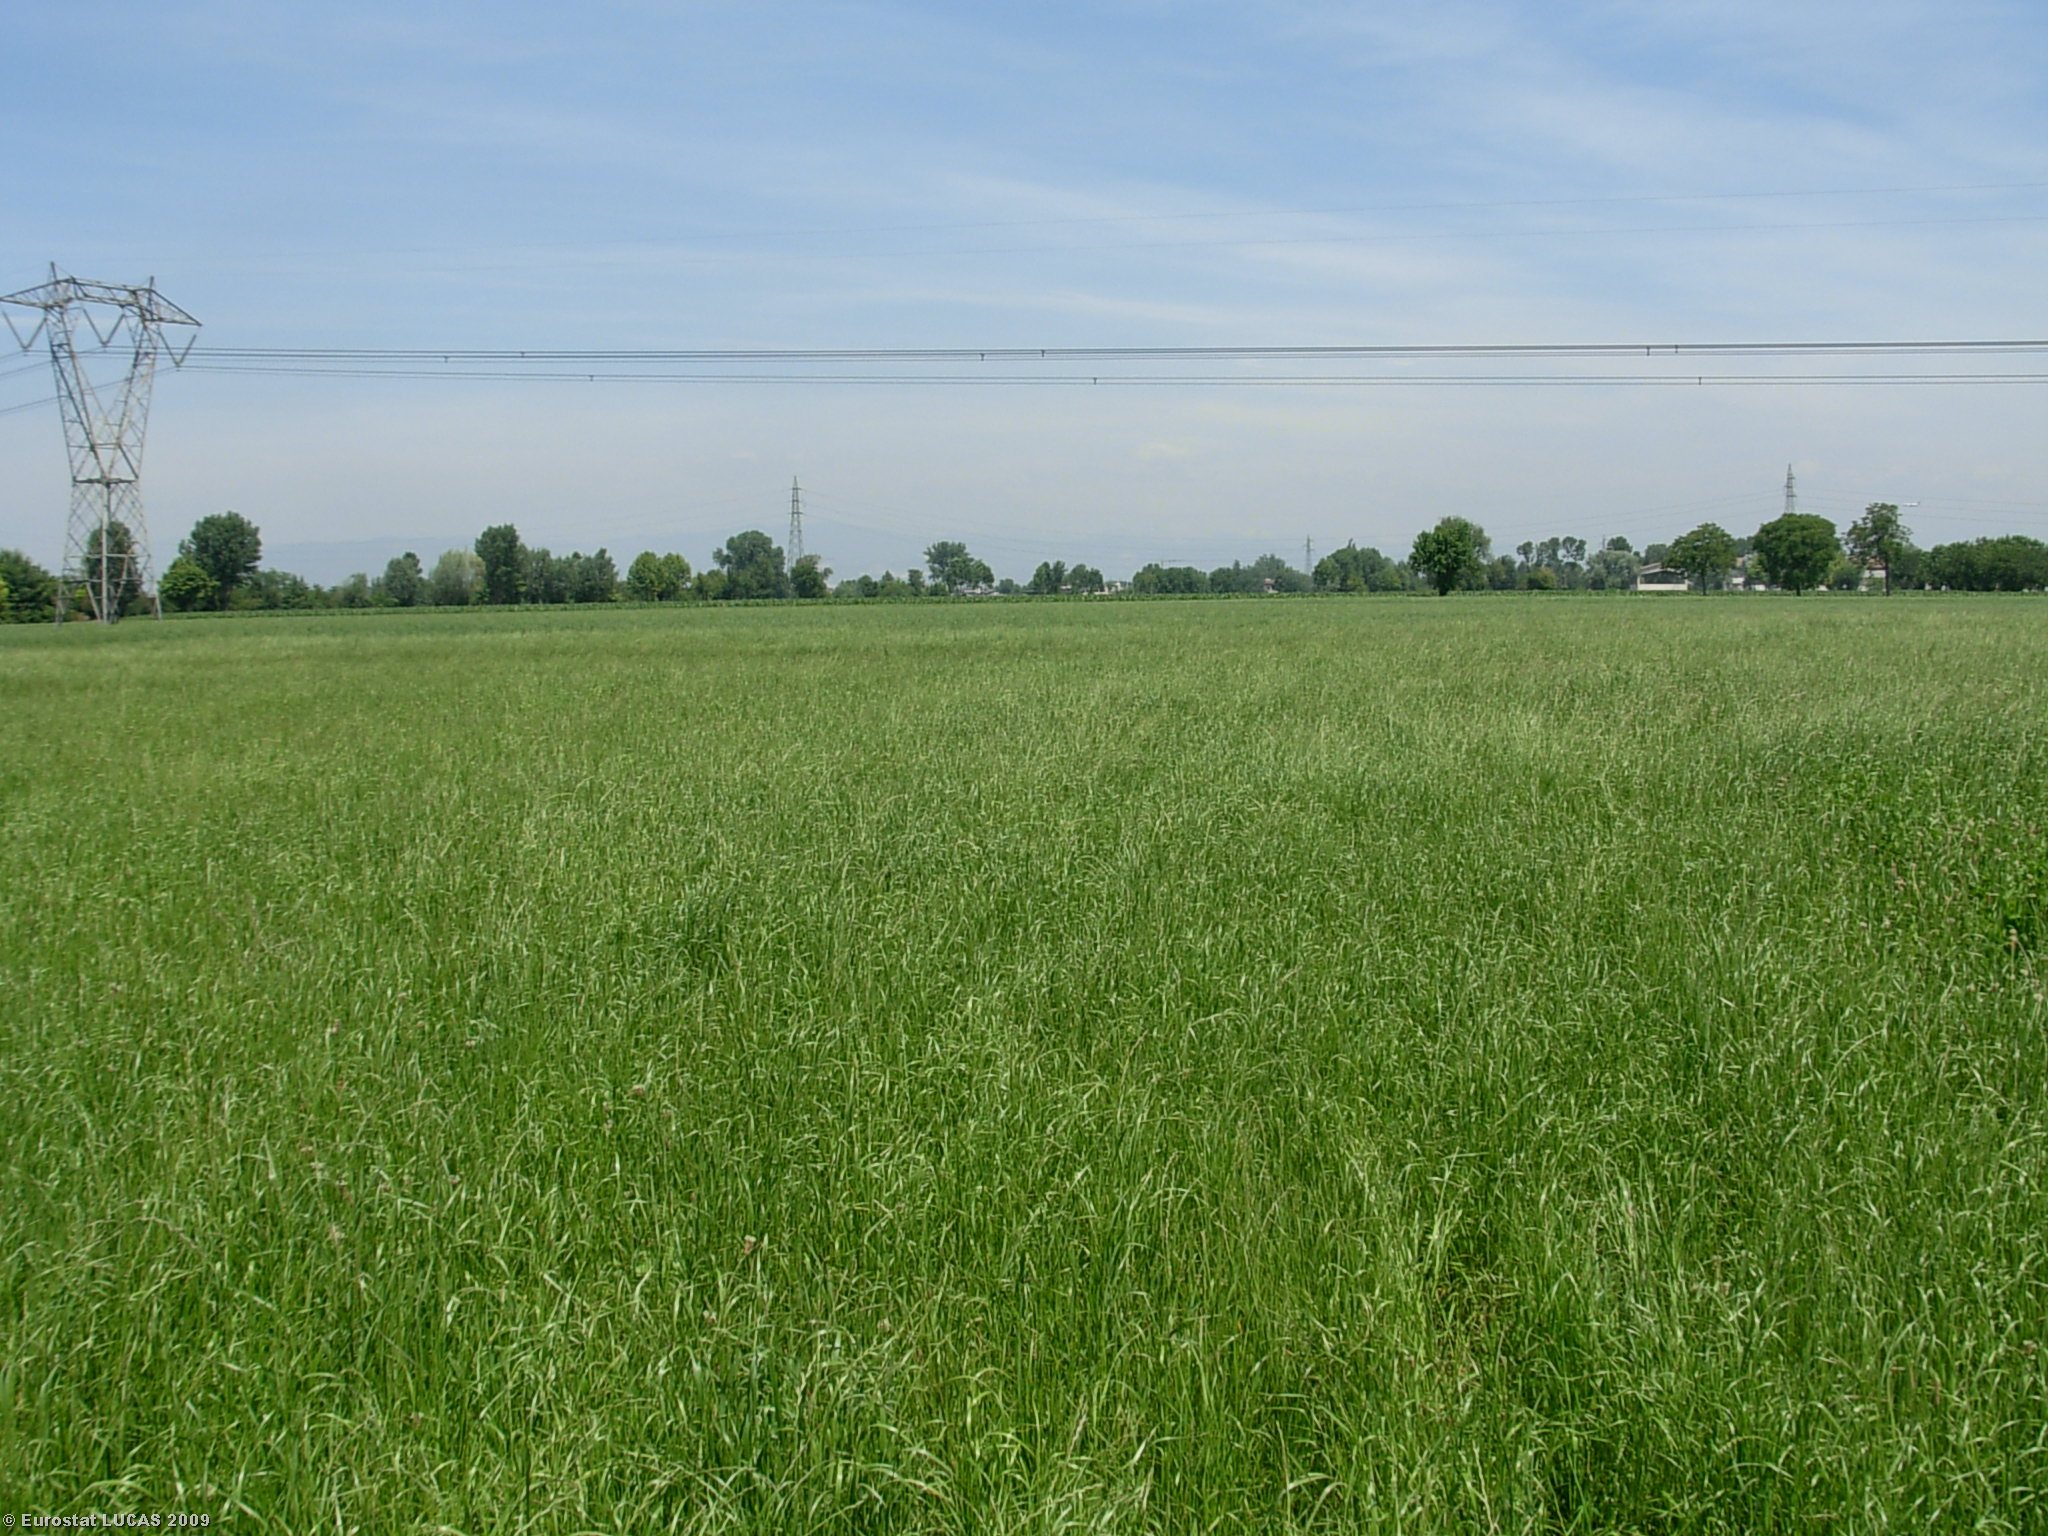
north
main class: Grassland
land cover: Grassland without tree/shrub cover
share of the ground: > 75 %
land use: Agriculture (excluding fallow land and kitchen gardens)
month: June
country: IT
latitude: 45.3597
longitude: 10.3441
